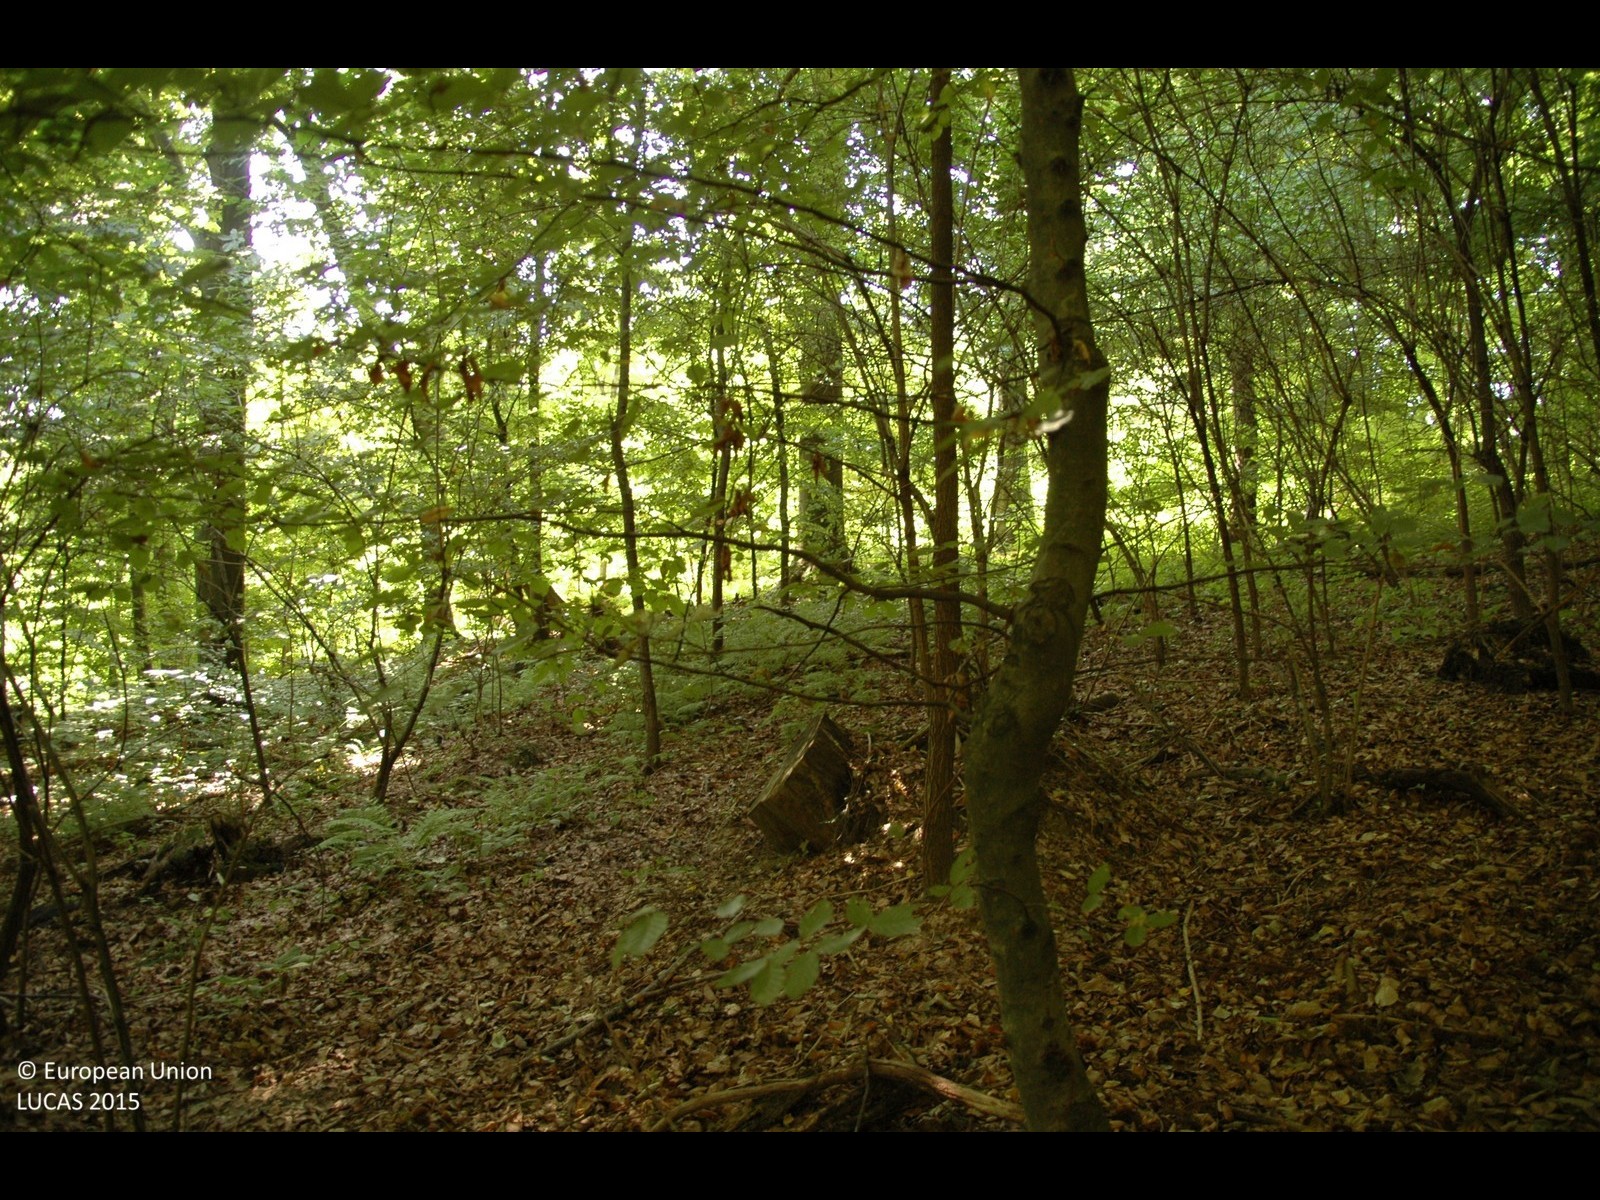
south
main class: Woodland
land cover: Broadleaved woodland
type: beech forest
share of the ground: > 75 %
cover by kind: broadleaved forest trees 100 %
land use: Forestry
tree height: > 5 m
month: August
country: HR
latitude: 46.1757
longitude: 16.7238
